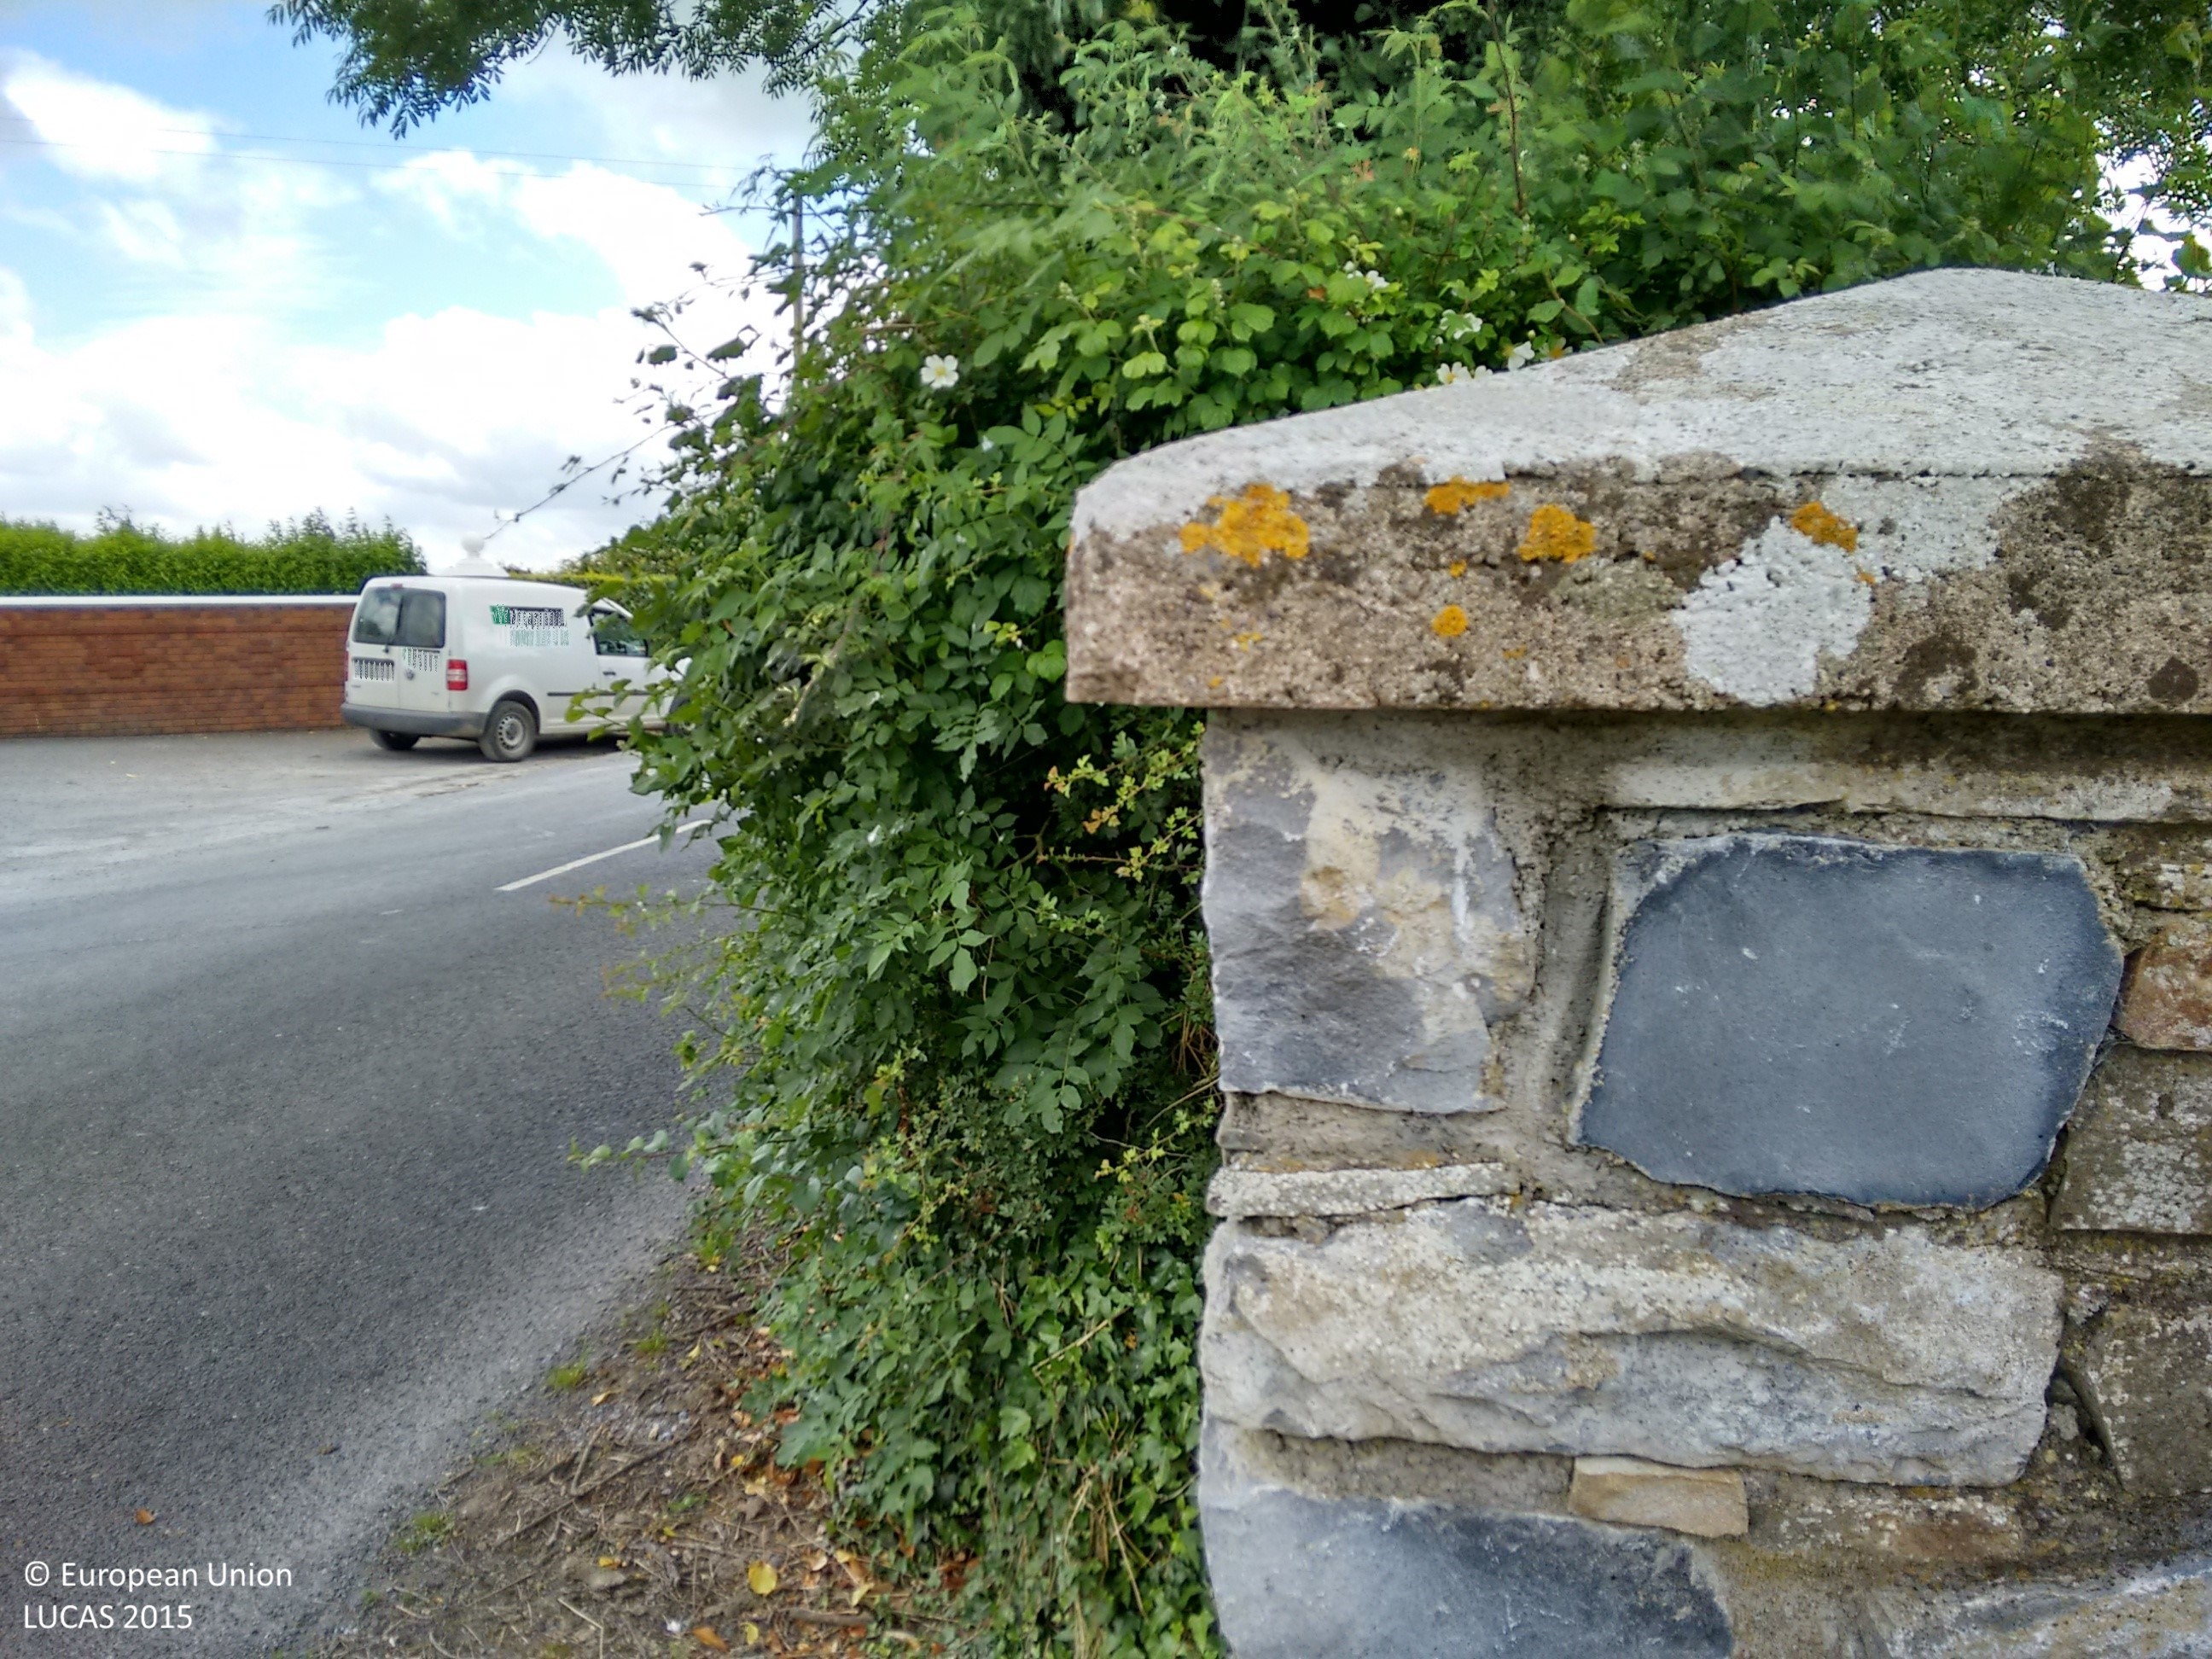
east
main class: Grassland
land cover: Grassland without tree/shrub cover
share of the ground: > 75 %
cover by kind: herbaceous plants 100 %
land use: Agriculture (excluding fallow land and kitchen gardens)
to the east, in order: Grassland without tree/shrub cover; Electric lines; Grassland without tree/shrub cover; Electric lines; Grassland without tree/shrub cover; Fences; Abandoned hedges; Fences; Grassland without tree/shrub cover; Fences; Abandoned hedges; Paved roads, cycling and walking lanes; Electric lines; Abandoned hedges; Grassland without tree/shrub cover
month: July
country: IE
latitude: 52.5262
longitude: -7.6907
